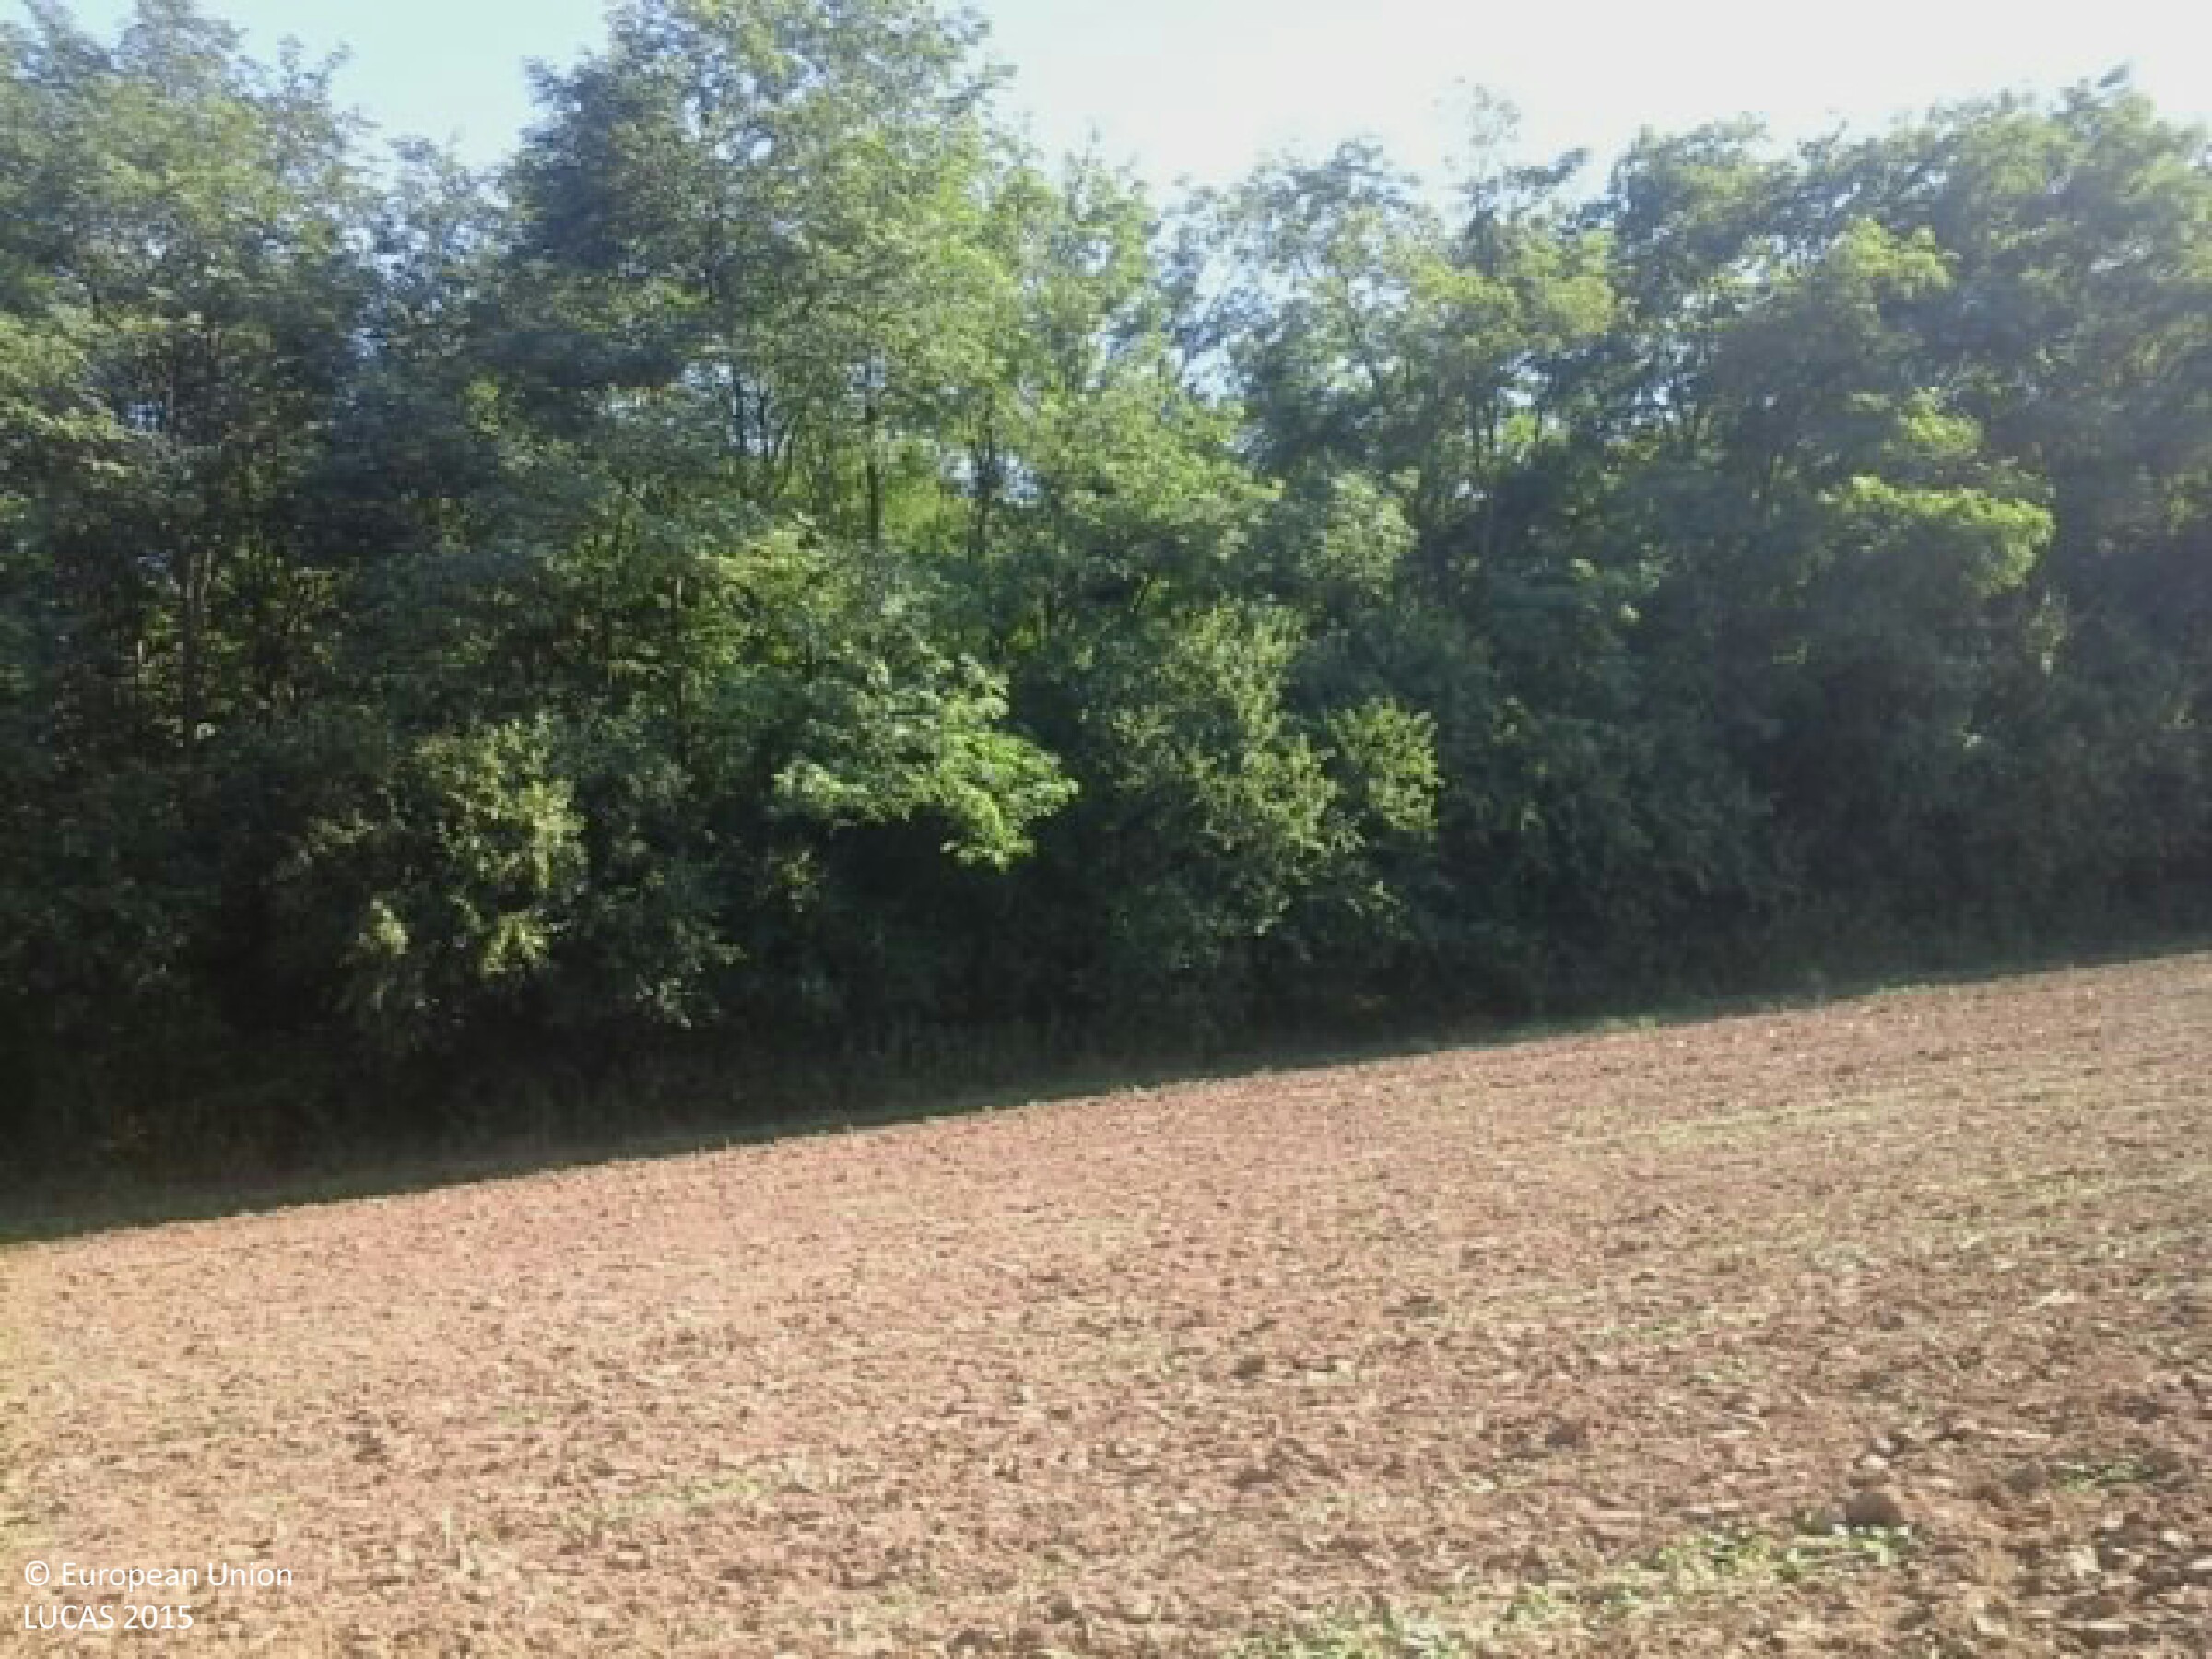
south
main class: Cropland
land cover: Common wheat
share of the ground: < 10 %
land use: Agriculture (excluding fallow land and kitchen gardens)
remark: Harvested field
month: July
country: HU
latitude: 46.4853
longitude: 17.7570
